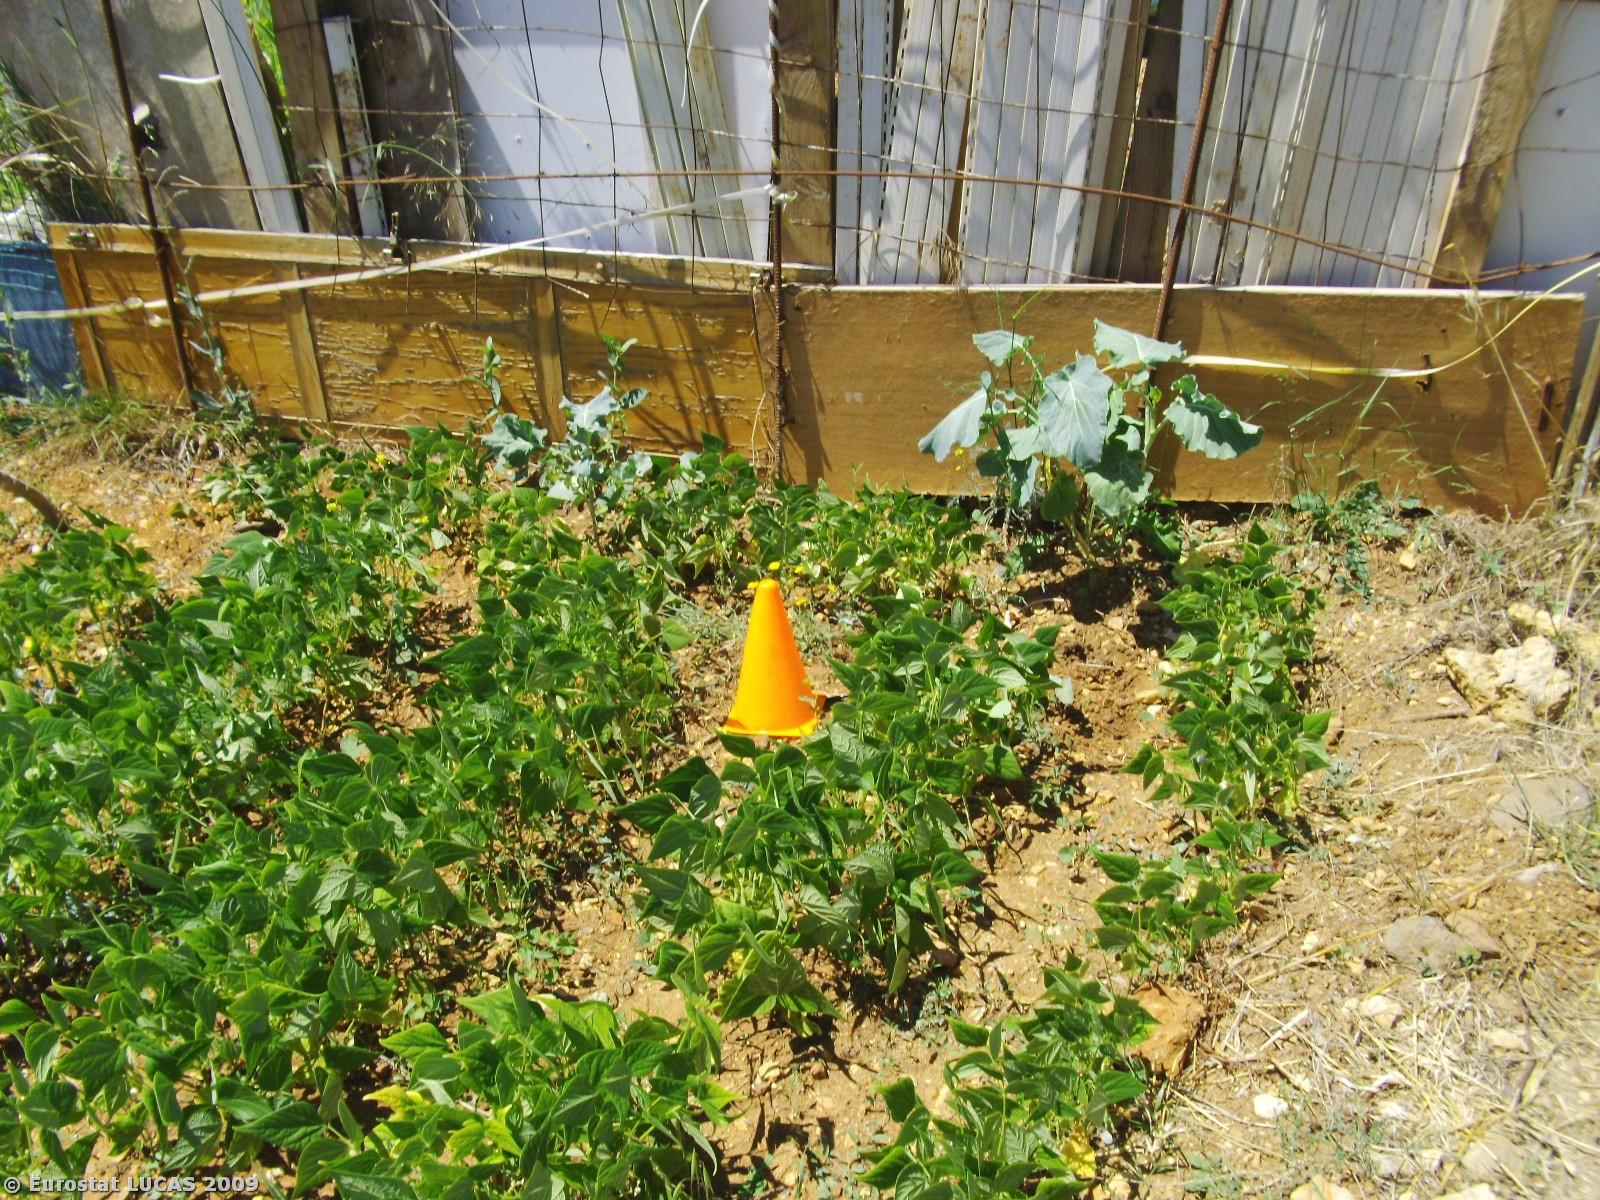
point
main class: Cropland
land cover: Dry pulses
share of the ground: 50 - 75 %
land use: Kitchen garden
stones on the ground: > 50 %
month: July
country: PT
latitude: 38.7685
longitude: -9.2421
